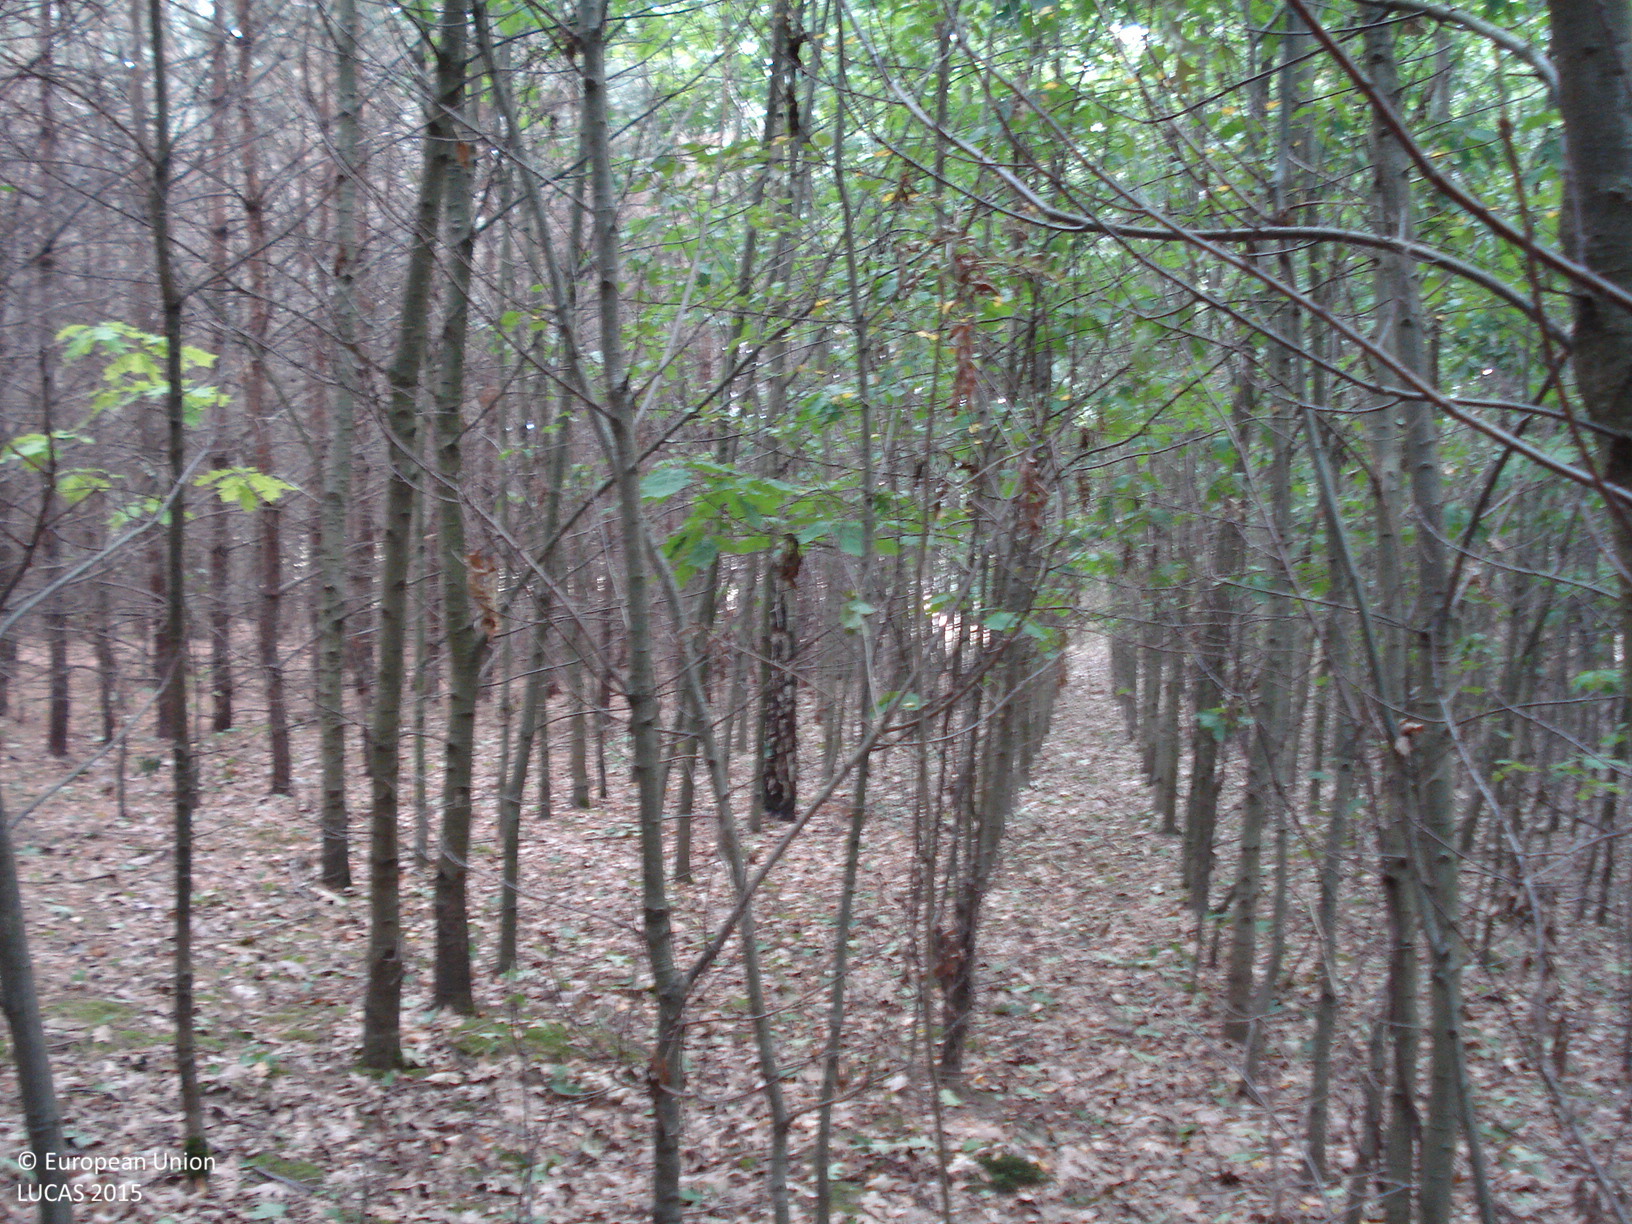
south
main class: Woodland
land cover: Broadleaved woodland
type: mesophytic deciduous forest
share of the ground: > 75 %
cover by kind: broadleaved forest trees 80 %, unconsolidated bare surface 15 %, herbaceous plants 5 %
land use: Forestry
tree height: < 5 m
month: September
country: PL
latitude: 50.8389
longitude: 20.9065
